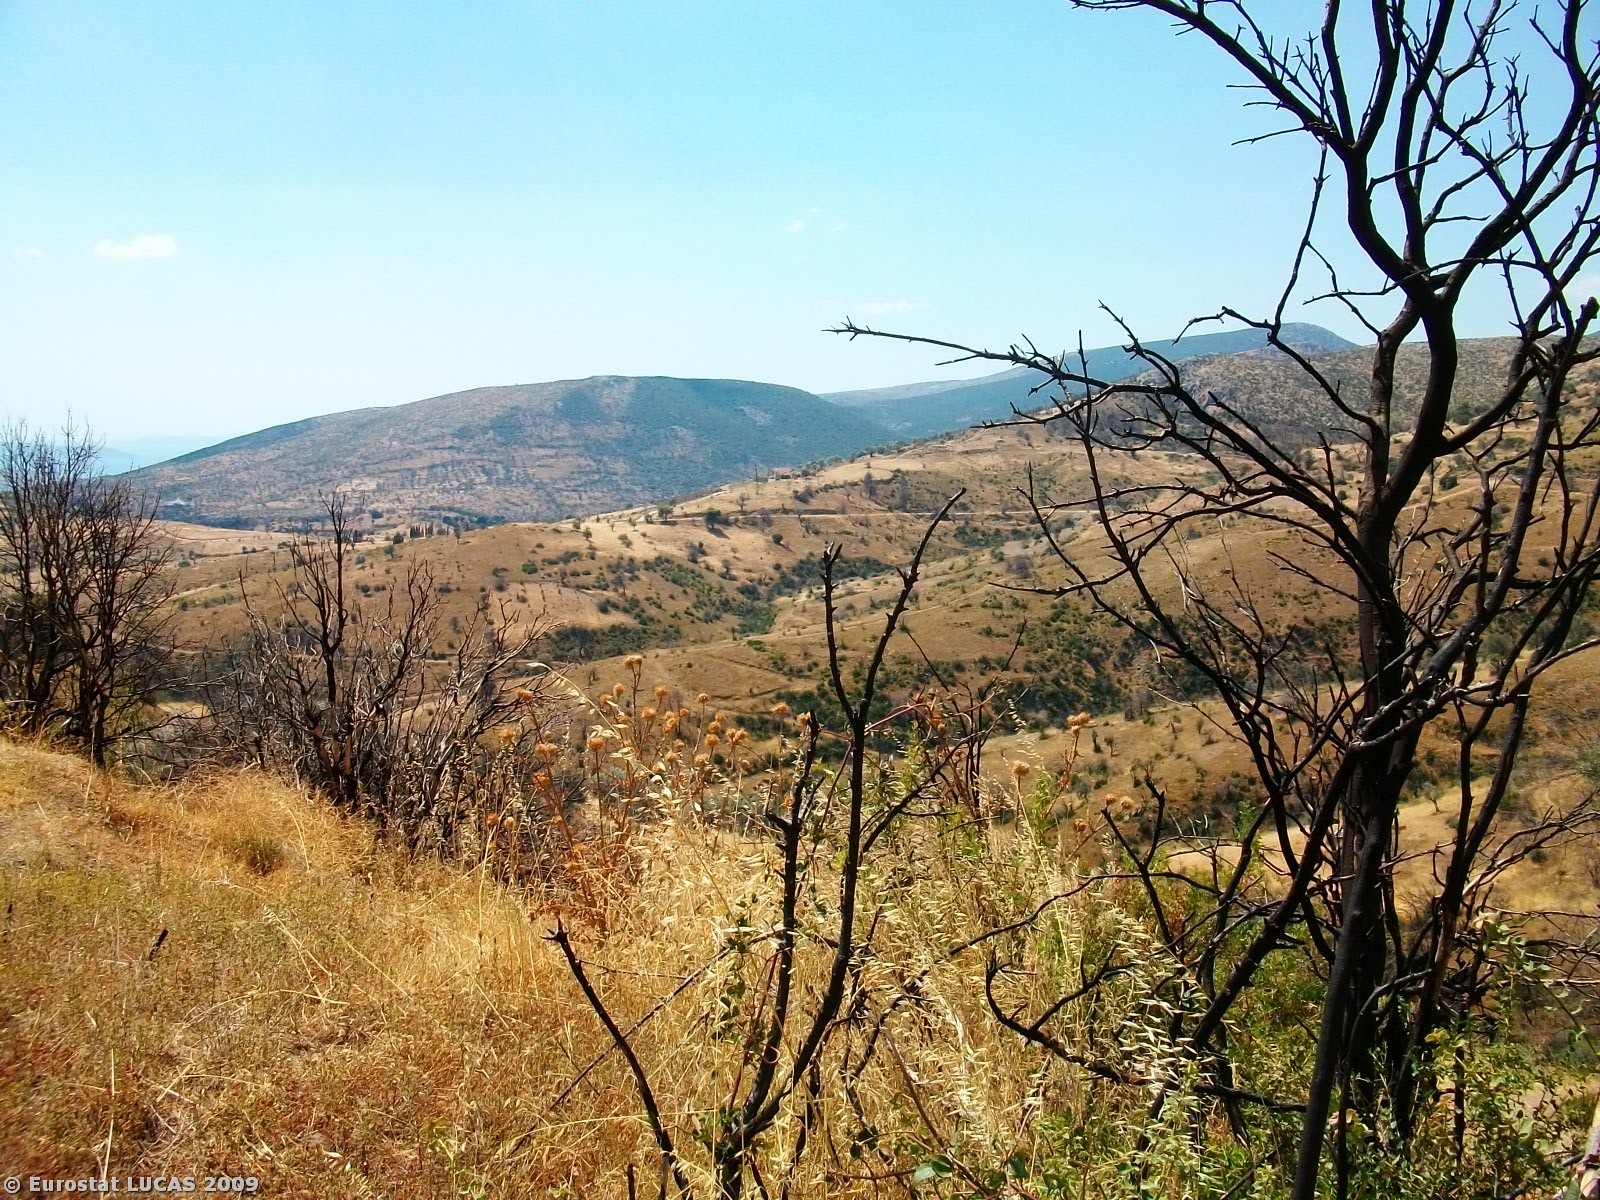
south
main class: Grassland
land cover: Grassland with sparse tree/shrub cover
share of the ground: > 75 %
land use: Unused
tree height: < 5 m
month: August
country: GR
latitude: 38.4925
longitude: 23.9668
